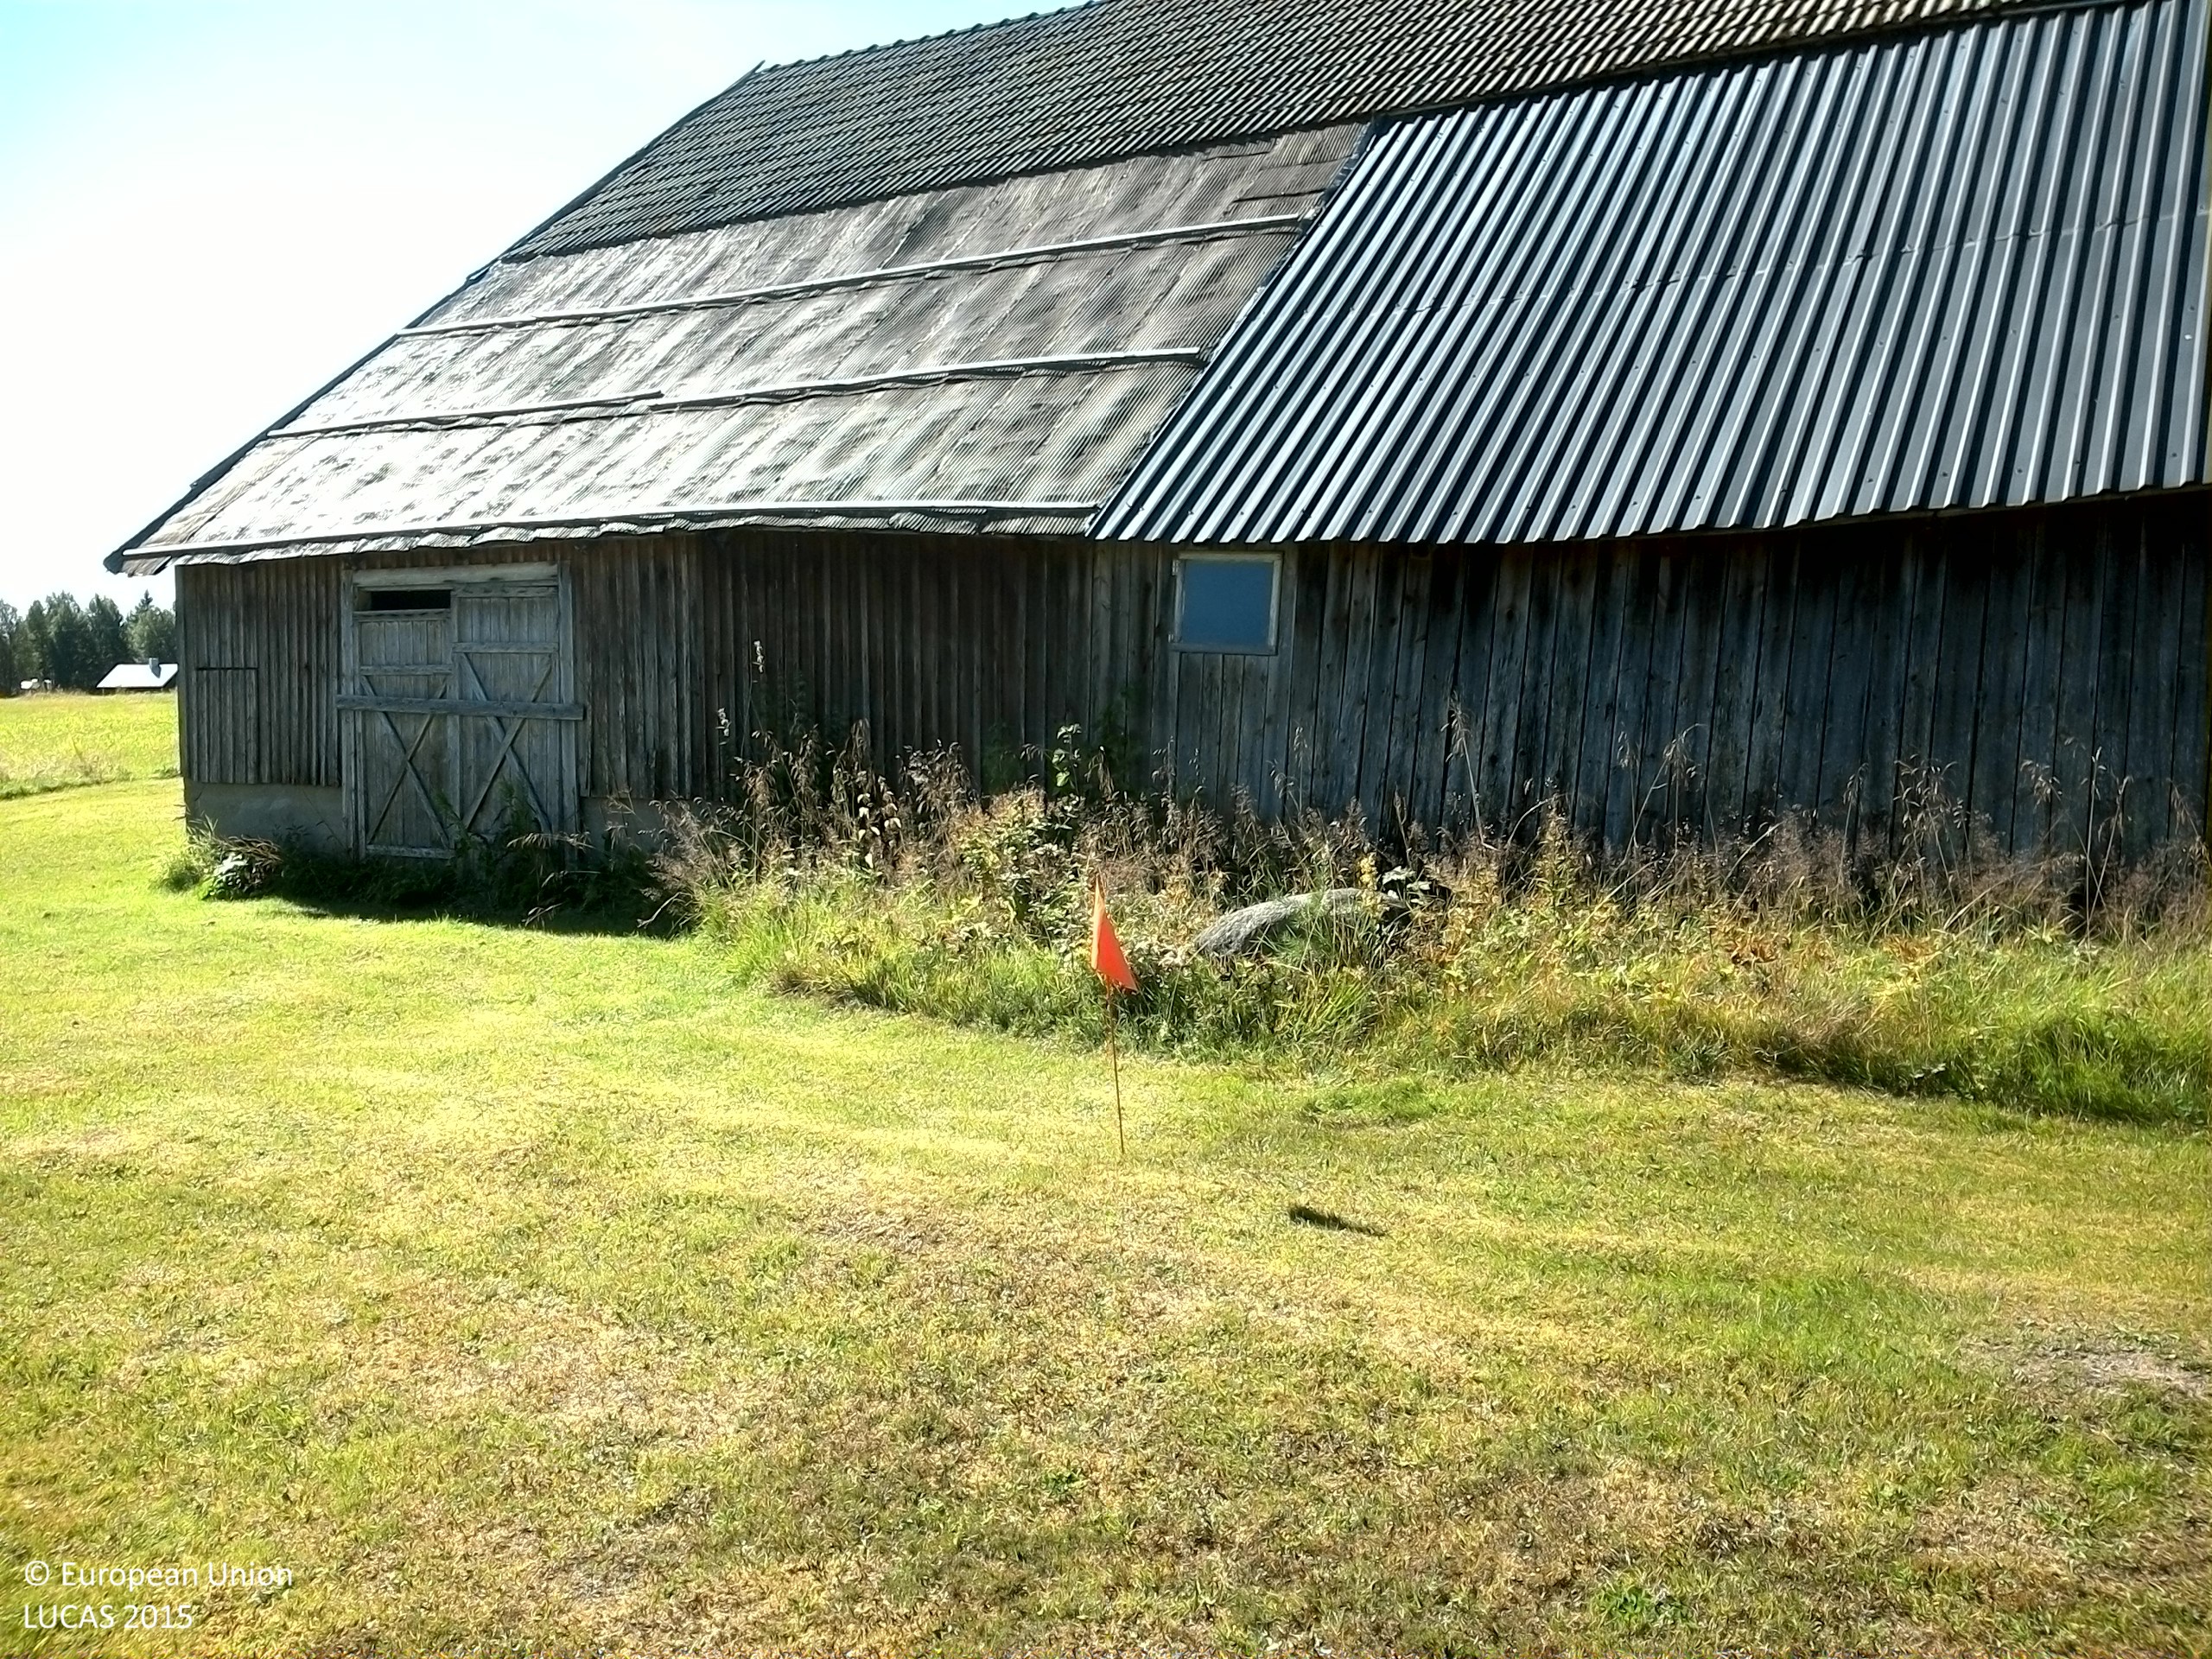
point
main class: Grassland
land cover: Grassland without tree/shrub cover
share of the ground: > 75 %
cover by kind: herbaceous plants 80 %, lichens and mosses 20 %
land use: Residential
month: August
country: SE
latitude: 63.7118
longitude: 17.8860
